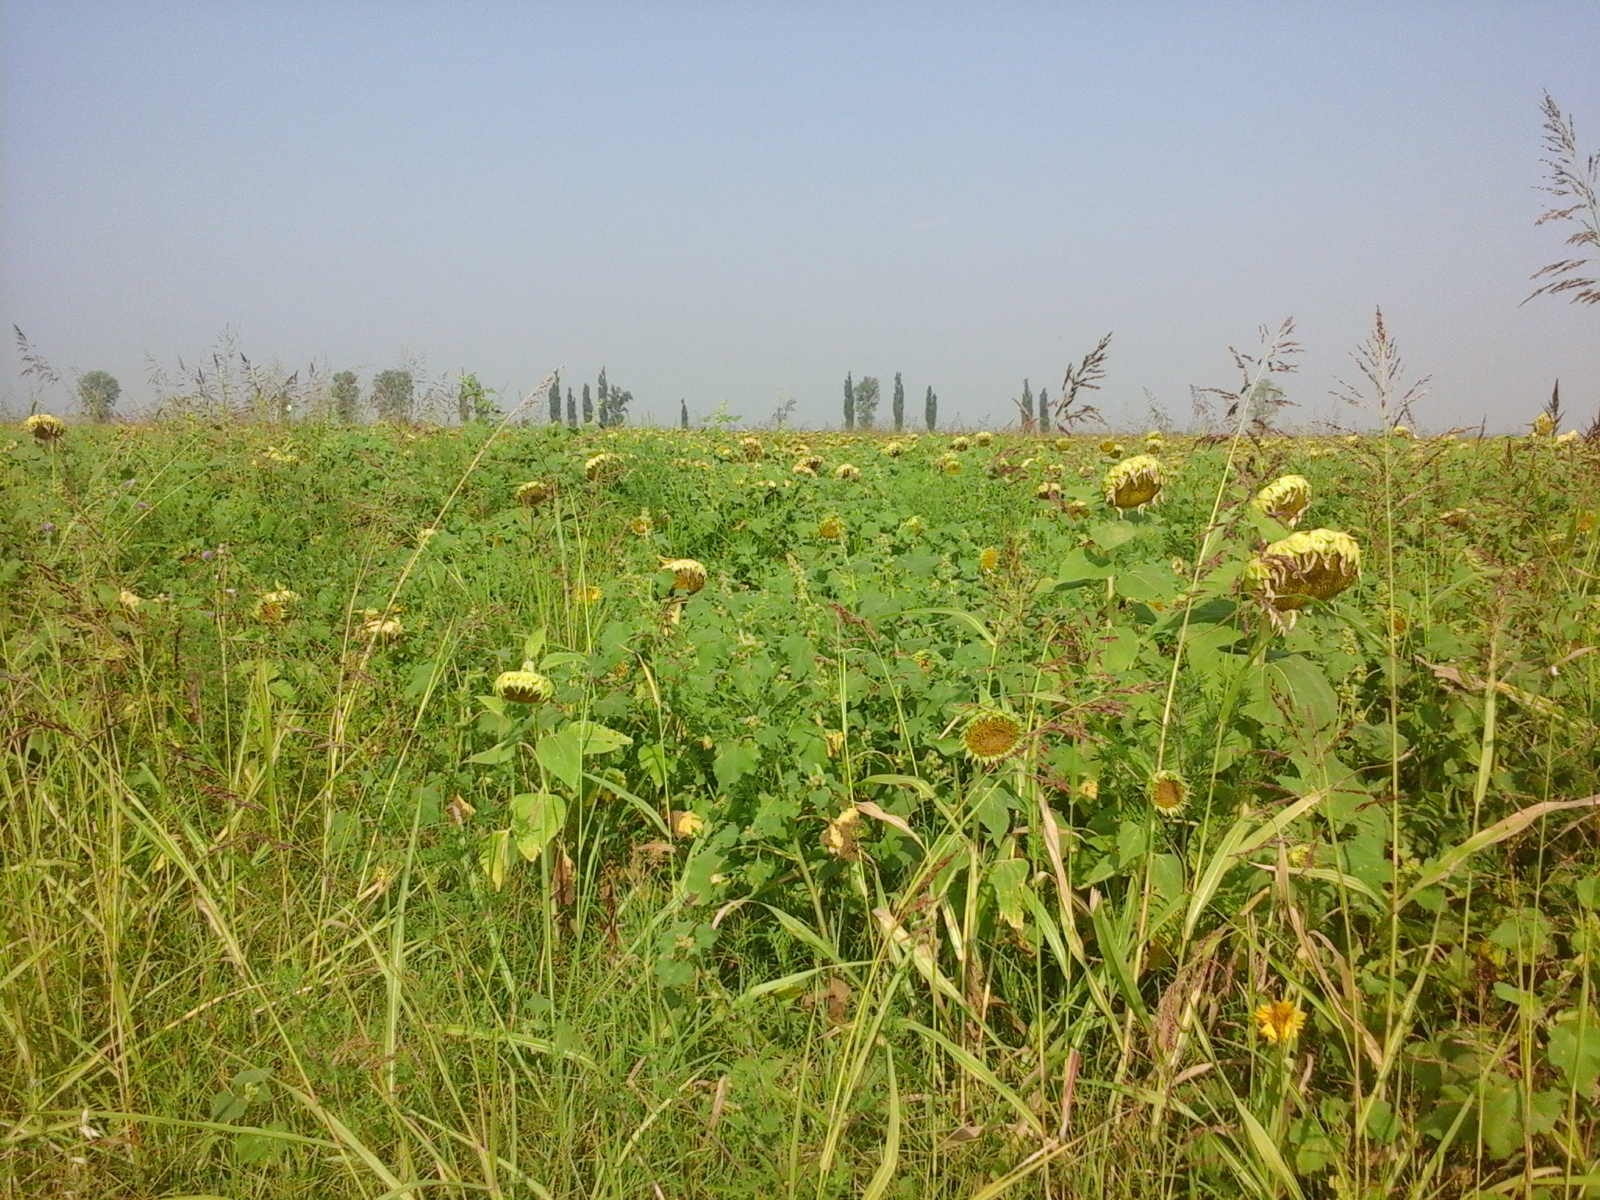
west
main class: Cropland
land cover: Sunflower
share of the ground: > 75 %
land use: Agriculture (excluding fallow land and kitchen gardens)
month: August
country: RO
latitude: 44.0381
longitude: 23.4383
